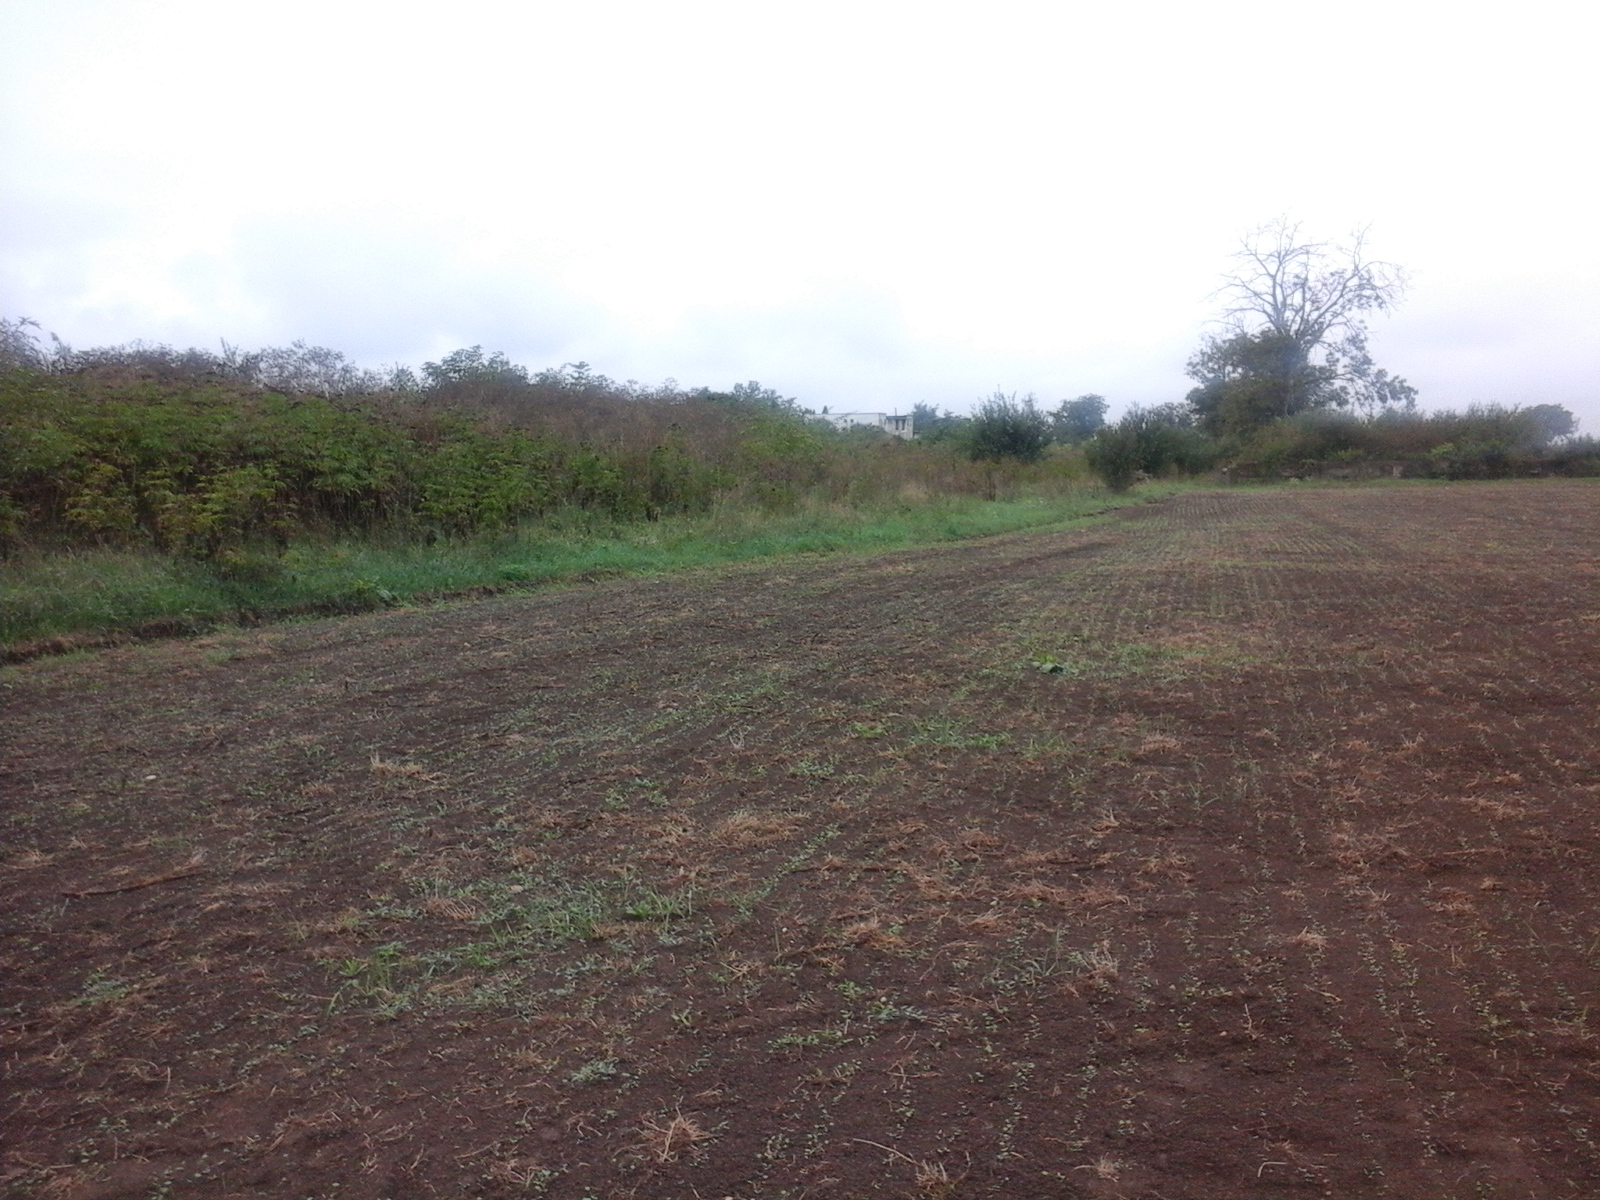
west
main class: Cropland
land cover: Dry pulses
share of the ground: < 10 %
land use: Agriculture (excluding fallow land and kitchen gardens)
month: September
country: RO
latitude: 47.0746
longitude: 21.8317
